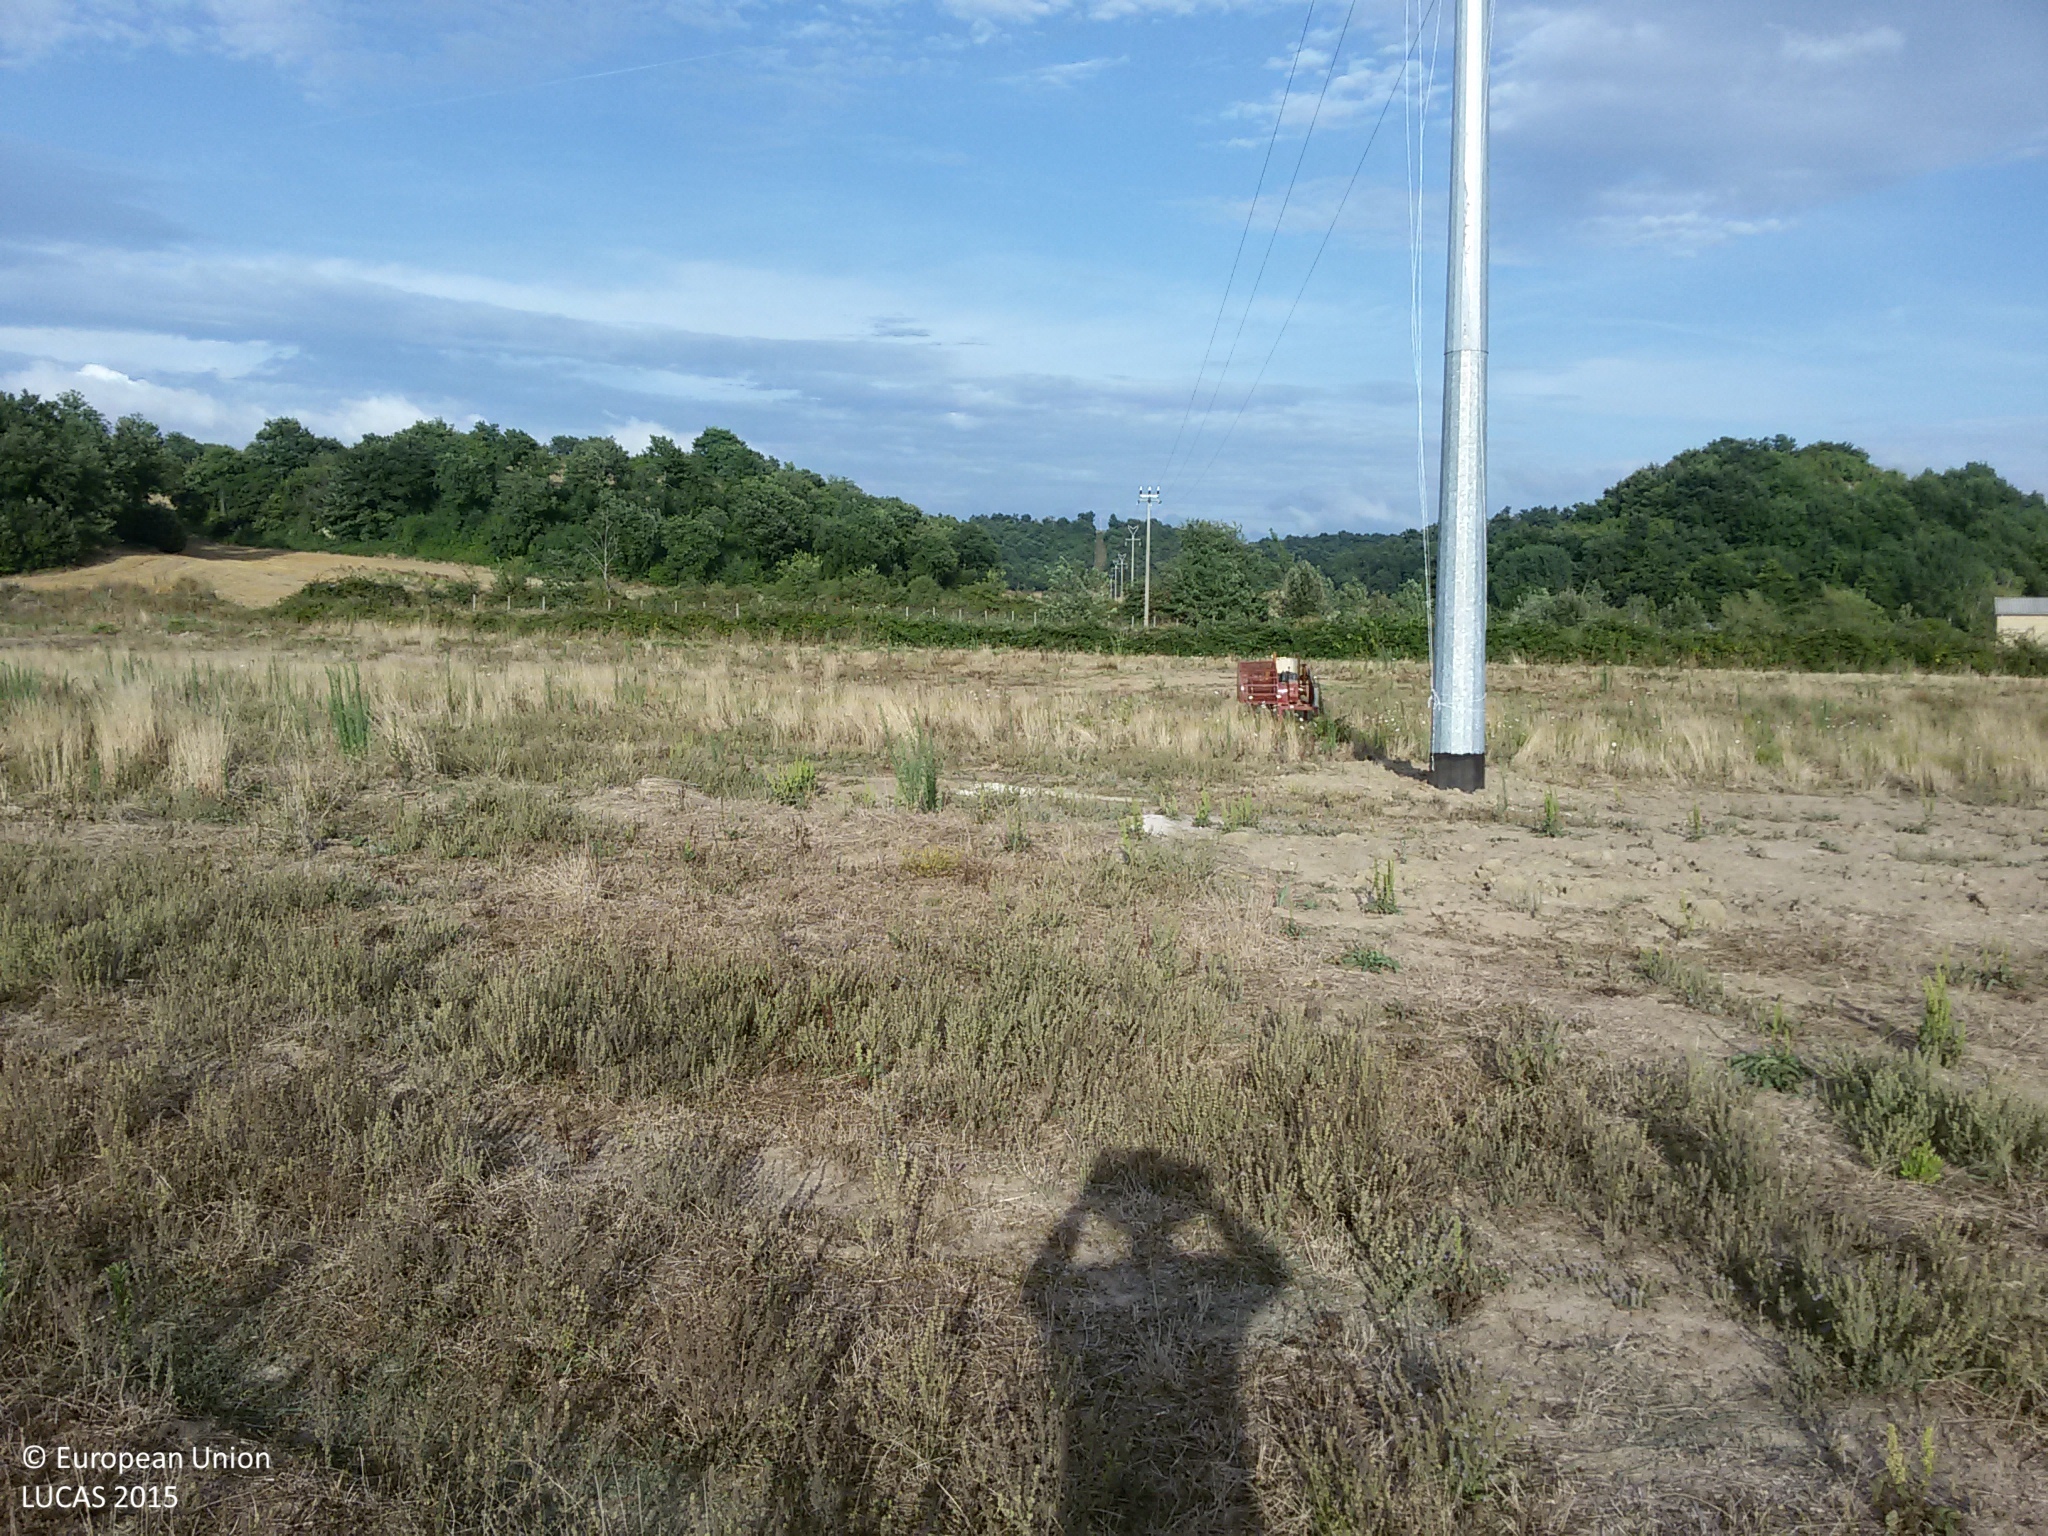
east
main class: Grassland
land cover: Grassland without tree/shrub cover
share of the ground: > 75 %
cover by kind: herbaceous plants 95 %, unconsolidated bare surface 5 %
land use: Agriculture (excluding fallow land and kitchen gardens)
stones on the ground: < 10 %
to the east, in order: Grassland without tree/shrub cover; Ditches and canals; Grassland without tree/shrub cover; Fences; Grass margins; Paved roads, cycling and walking lanes; Grass margins; Fences; Abandoned hedges; Barley; Ditches and canals; Barley
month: August
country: IT
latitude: 42.6054
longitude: 11.5914
